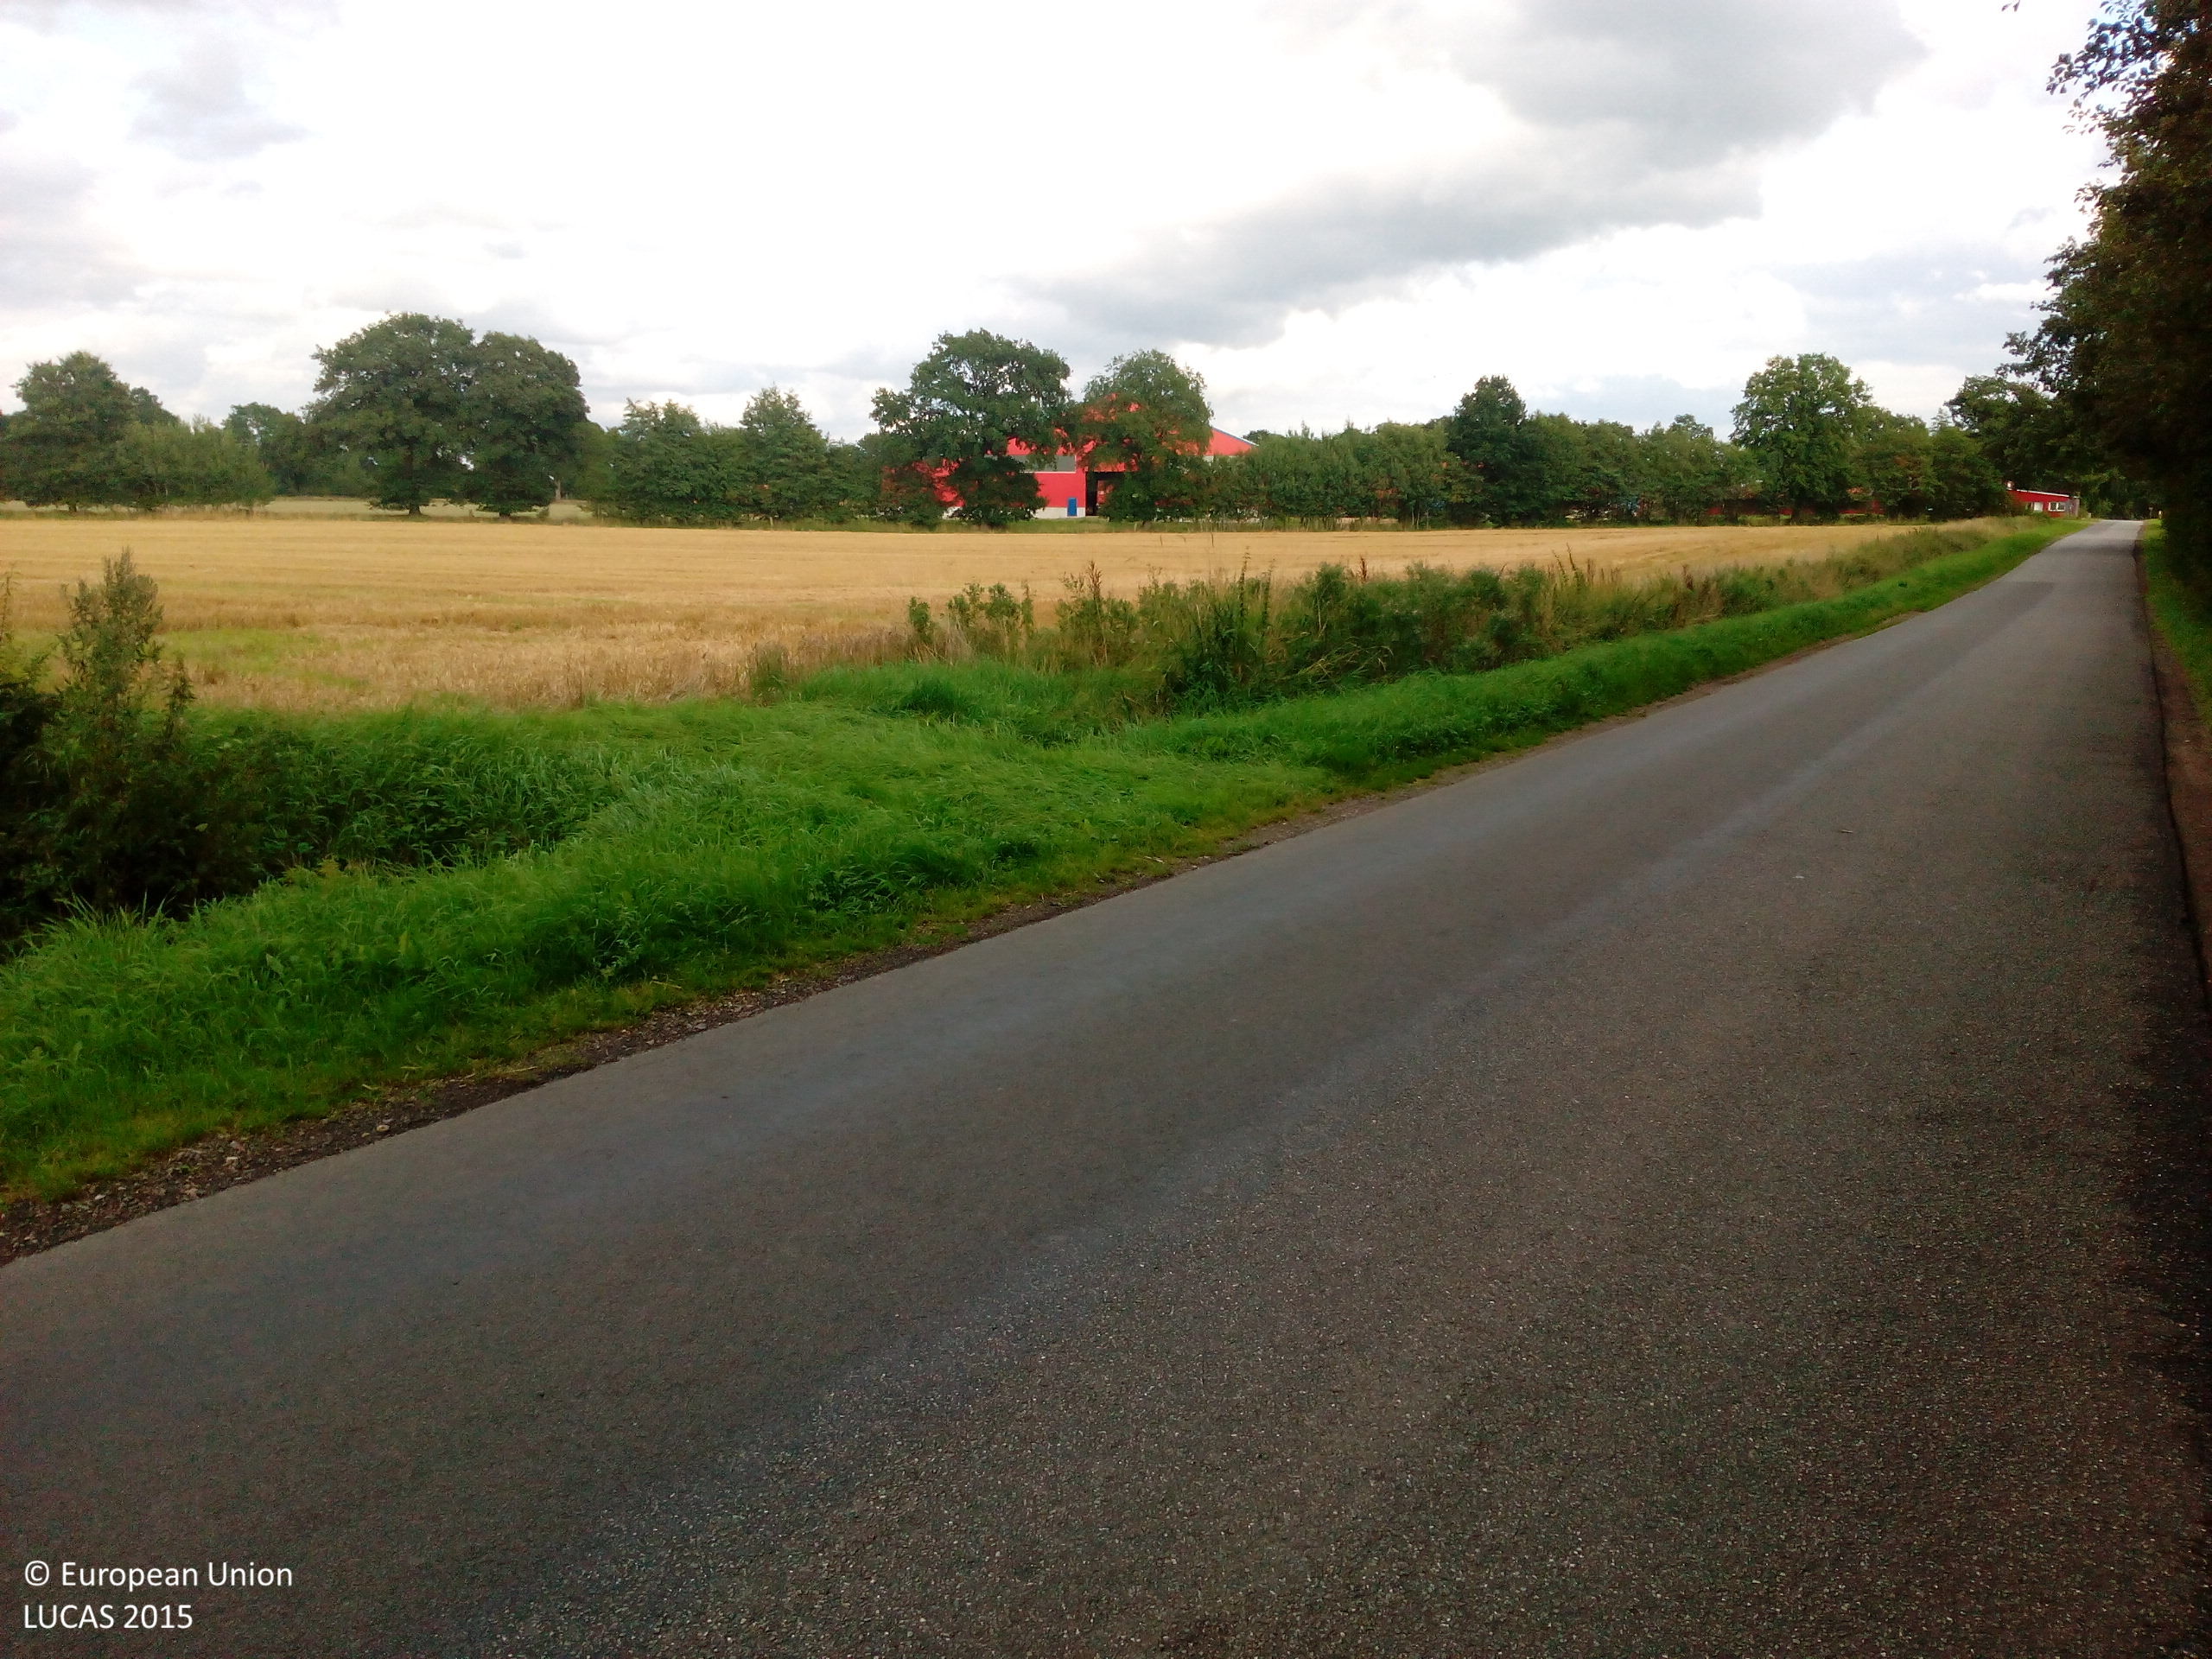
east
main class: Woodland
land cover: Broadleaved woodland
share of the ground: > 75 %
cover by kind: broadleaved forest trees 100 %
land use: Road transport
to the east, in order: Broadleaved woodland; Paved roads, cycling and walking lanes; Grass margins; Ditches and canals; Shruby margins; Common wheat; Ditches and canals; Broadleaved woodland; Grassland without tree/shrub cover; Artificial constructions in urban areas
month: August
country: DE
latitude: 53.7973
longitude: 9.9545
